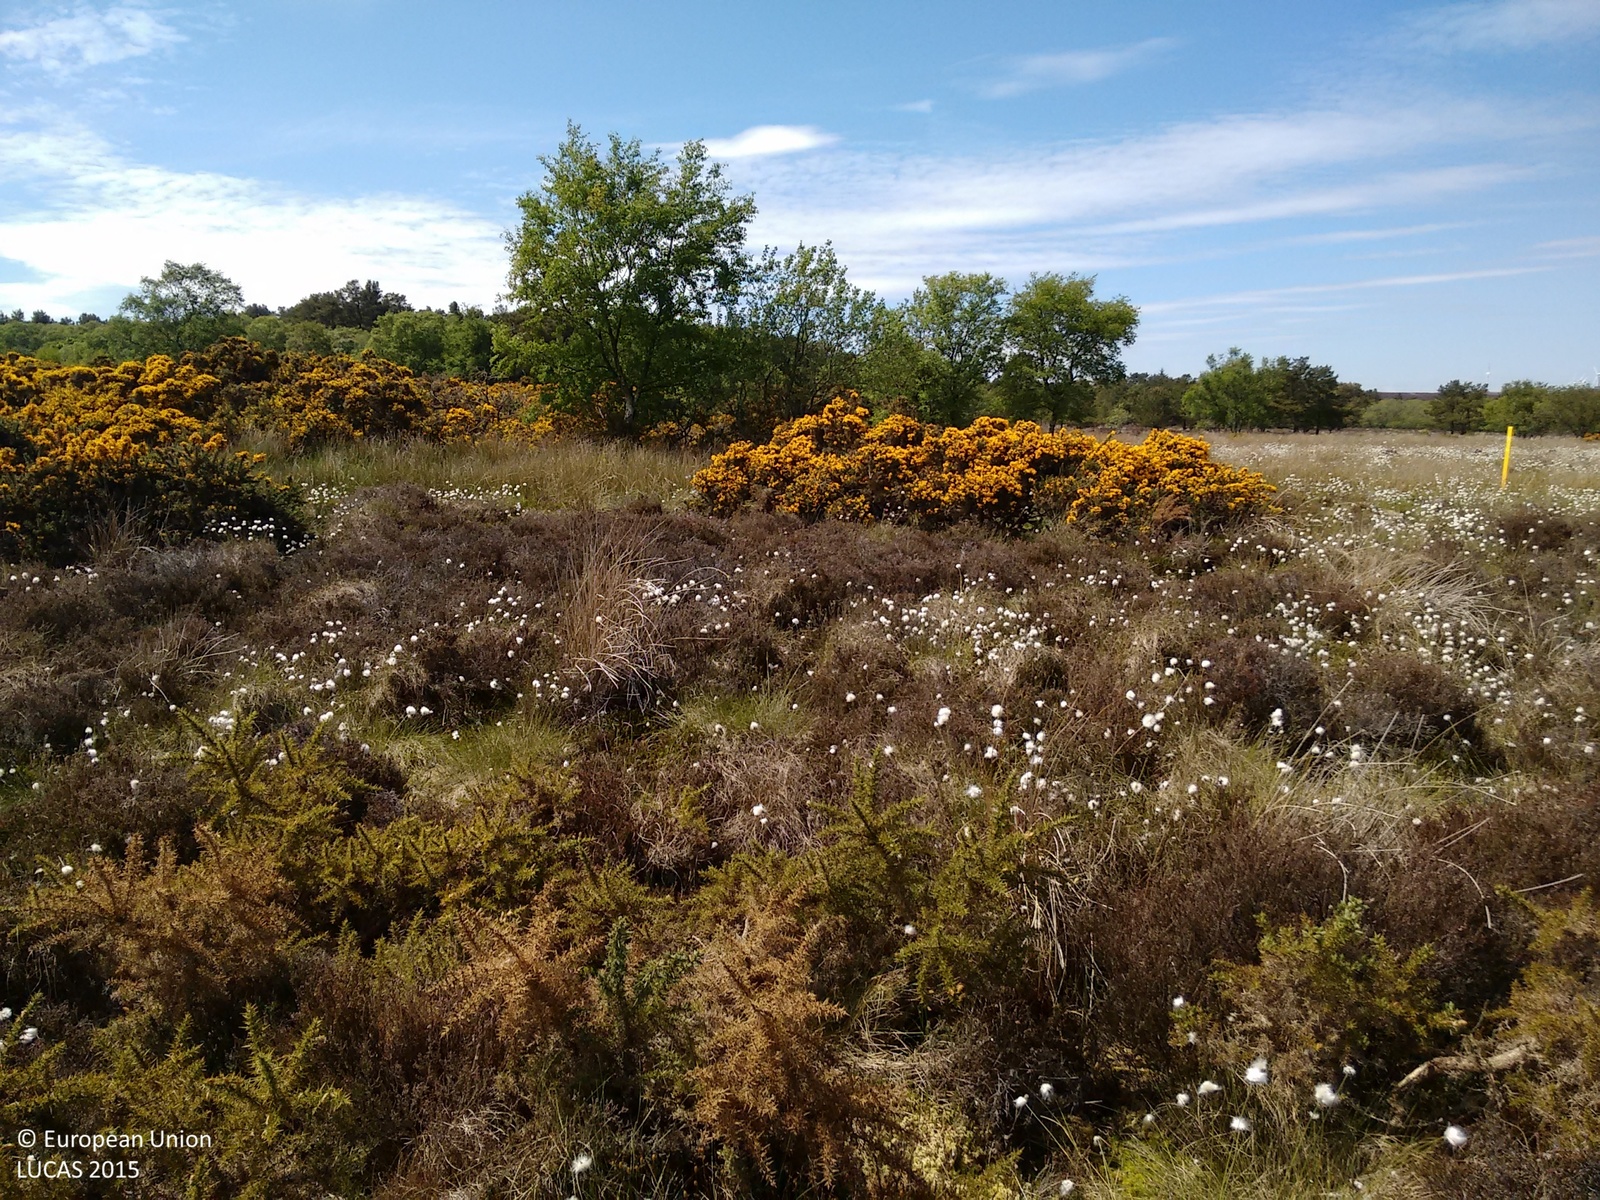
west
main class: Shrubland
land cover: Shrubland without tree cover
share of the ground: > 75 %
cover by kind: shrubs 65 %, herbaceous plants 20 %, lichens and mosses 15 %
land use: Semi-natural and natural areas not in use
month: June
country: GB
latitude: 57.0036
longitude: -2.2177
